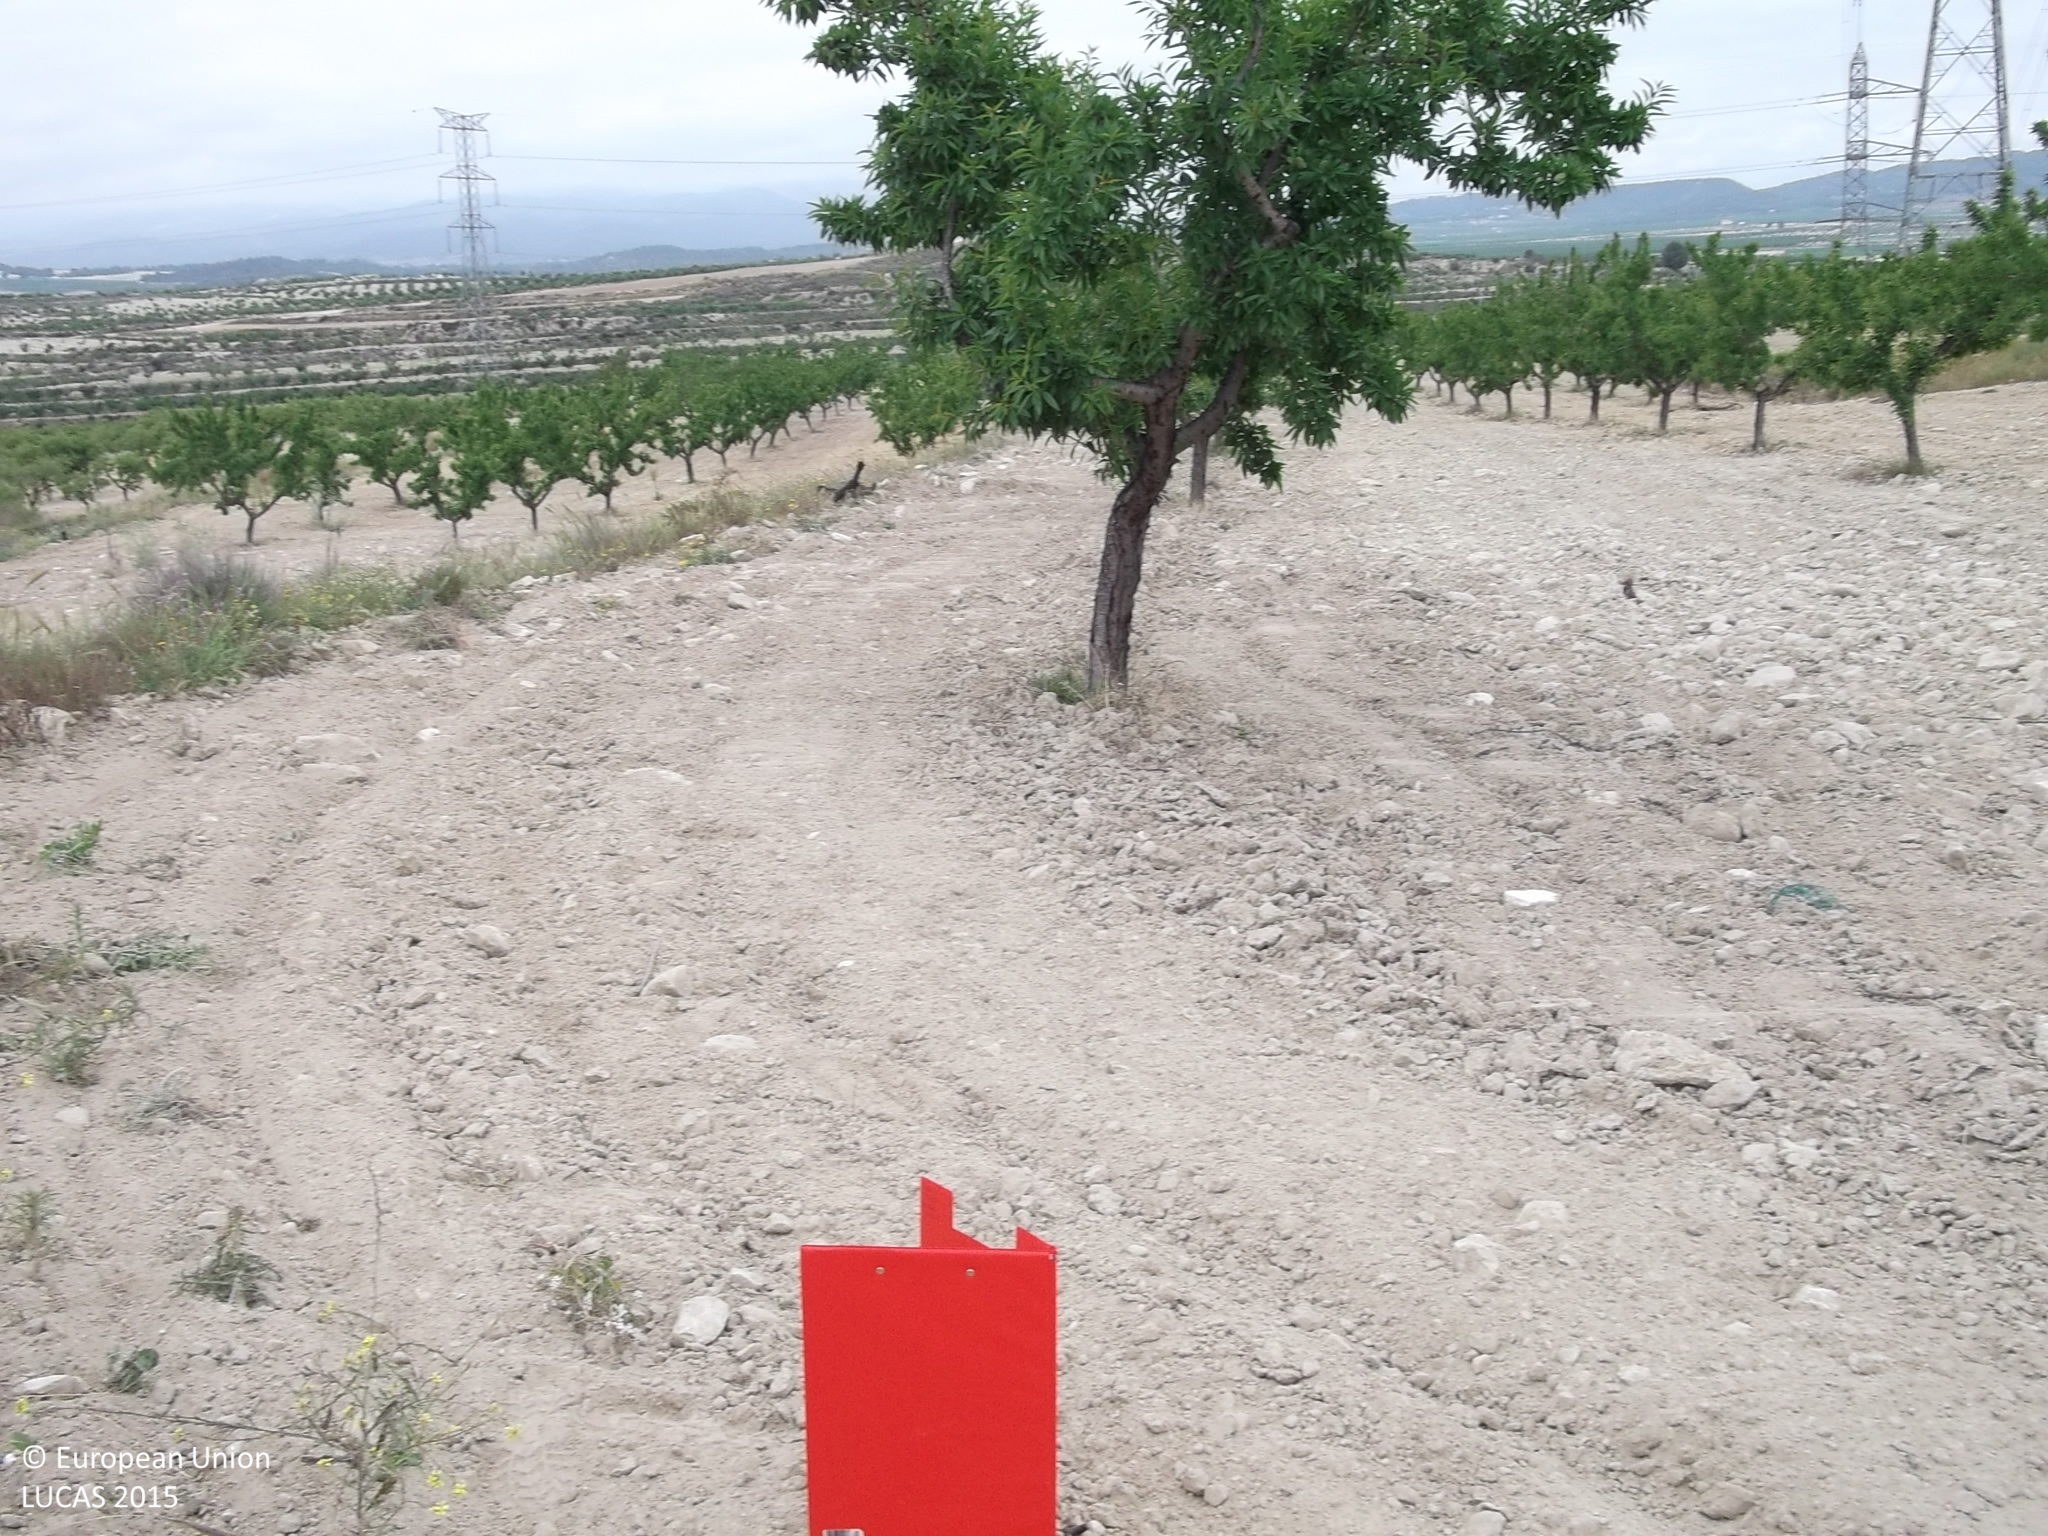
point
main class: Cropland
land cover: Nuts trees
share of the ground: 10 - 25 %
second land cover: Other bare soil
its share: > 75 %
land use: Agriculture (excluding fallow land and kitchen gardens)
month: April
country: ES
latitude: 37.9919
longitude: -1.4061
